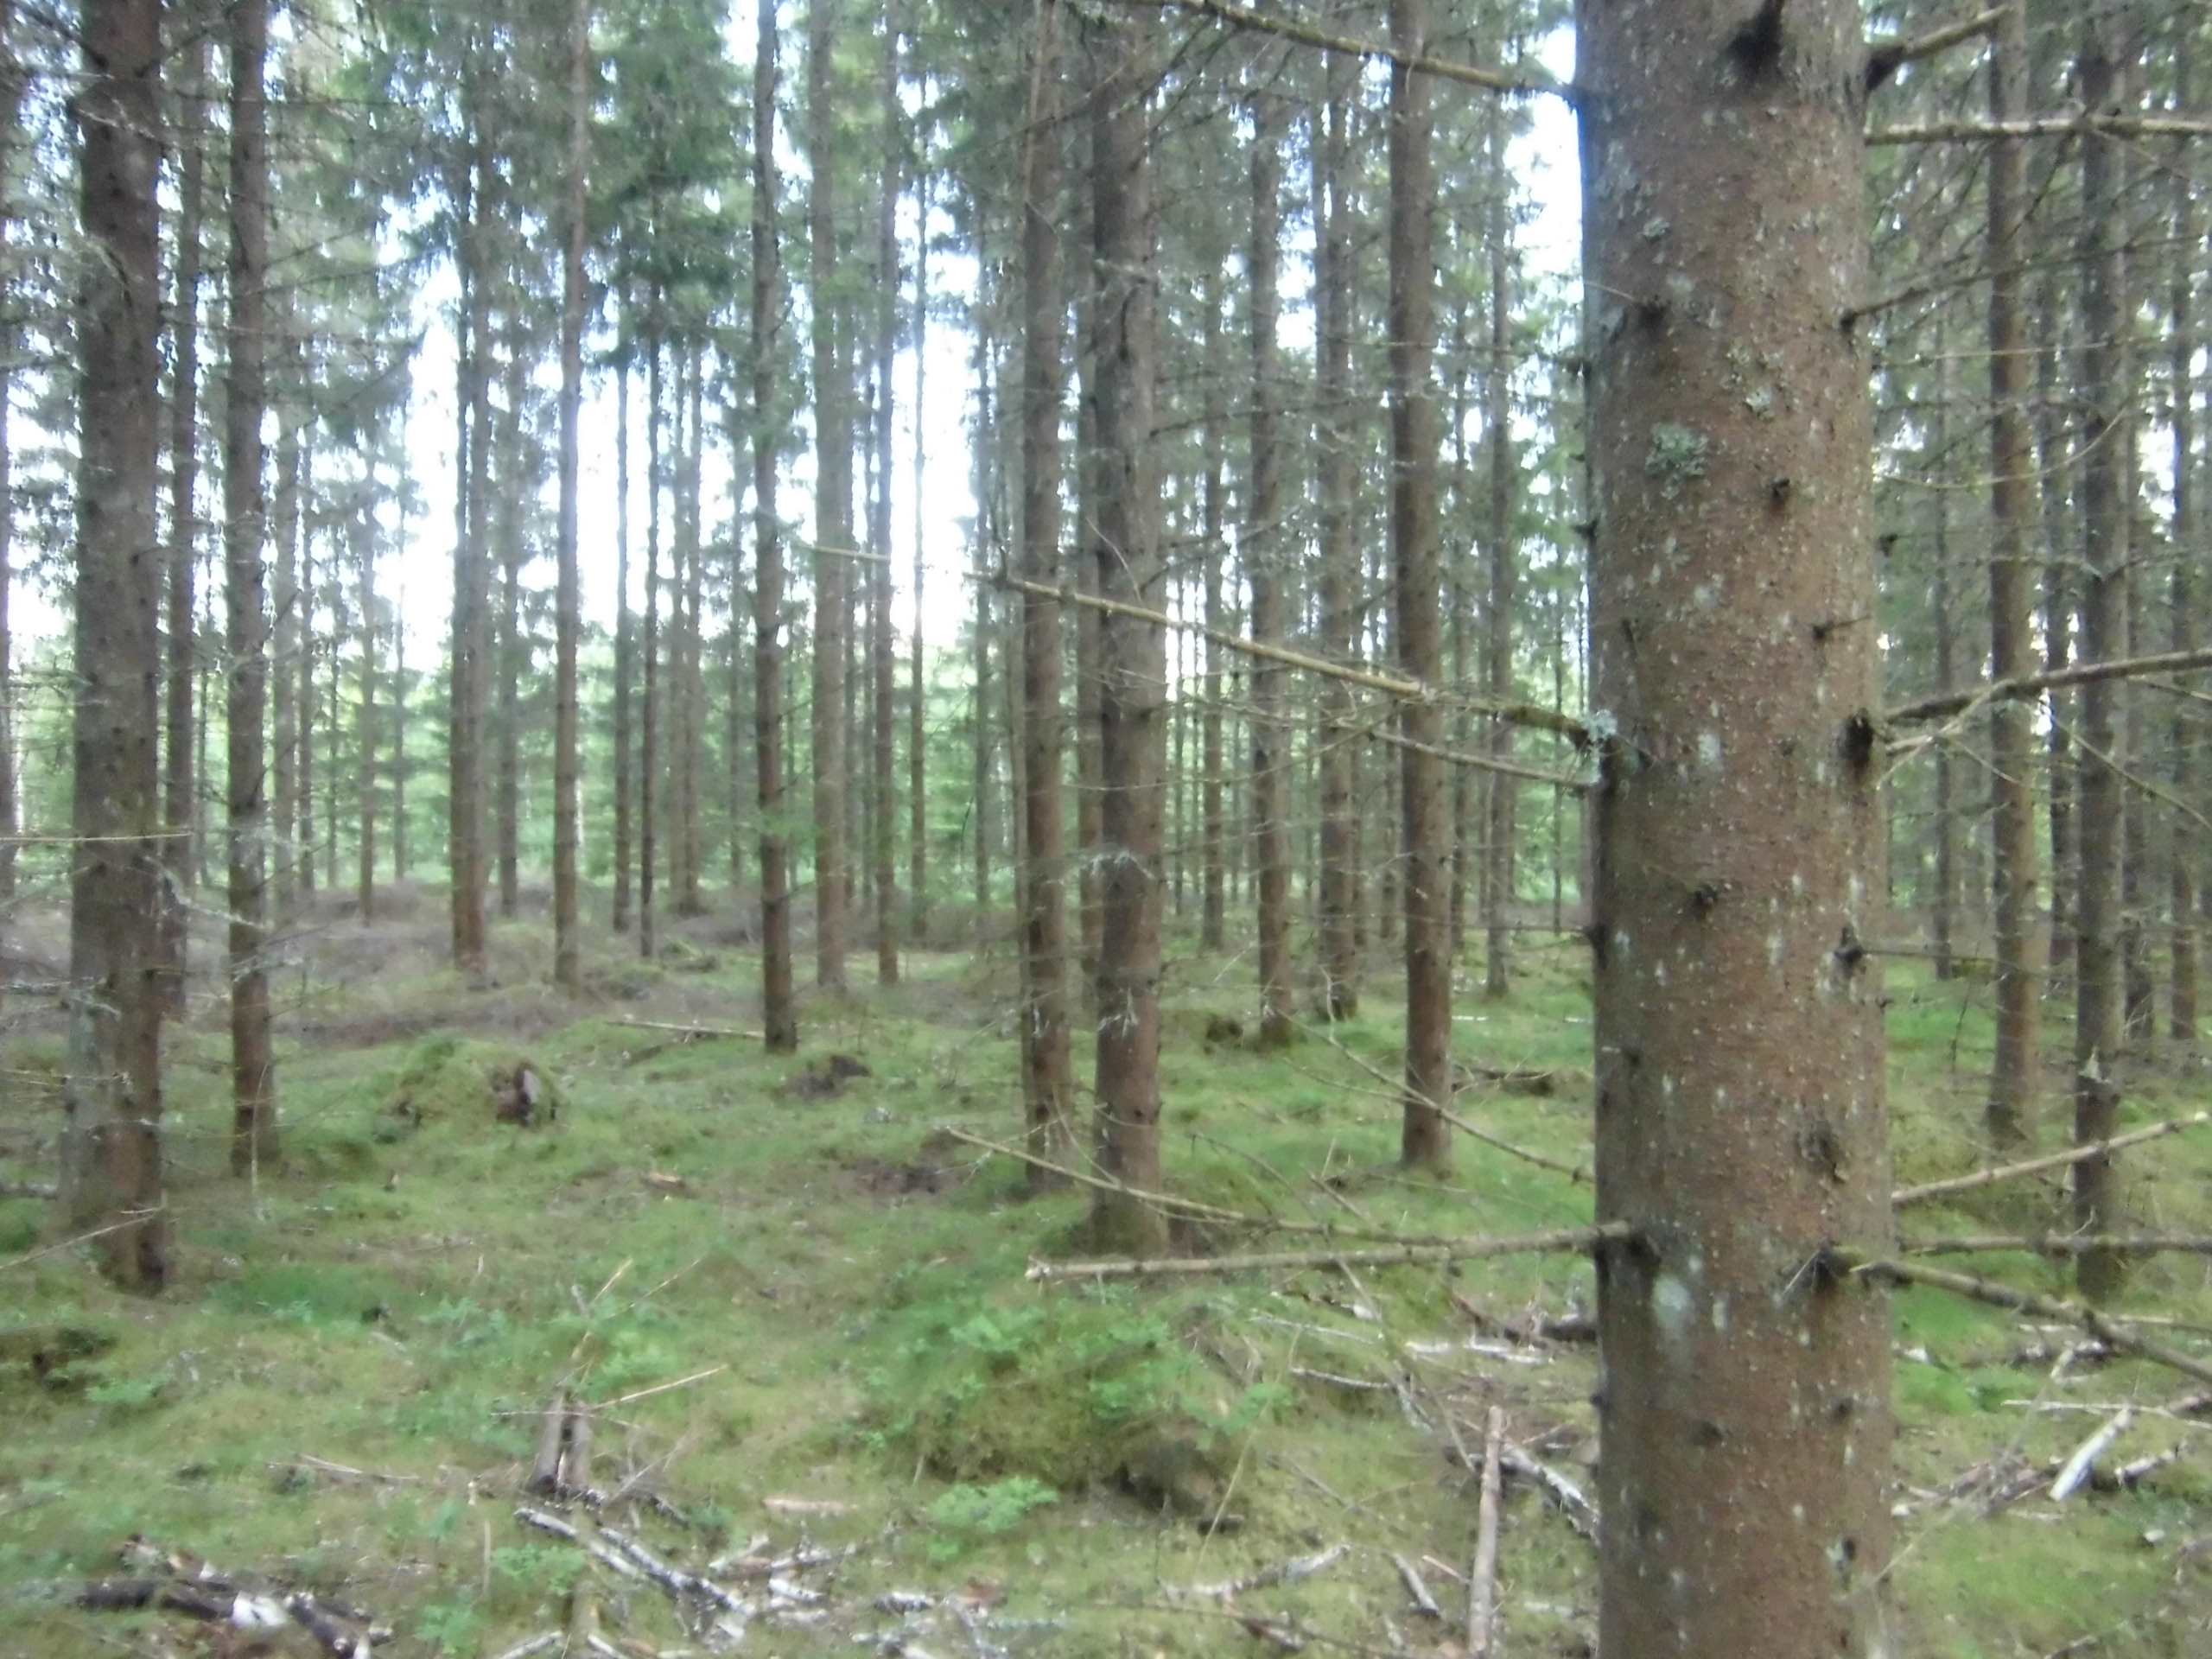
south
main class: Woodland
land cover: Spruce dominated coniferous woodland
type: boreal forest
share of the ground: 50 - 75 %
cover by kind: coniferous forest trees 65 %, shrubs 15 %, lichens and mosses 15 %, herbaceous plants 5 %
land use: Forestry
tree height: > 5 m
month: July
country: SE
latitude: 57.4475
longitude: 14.8450
